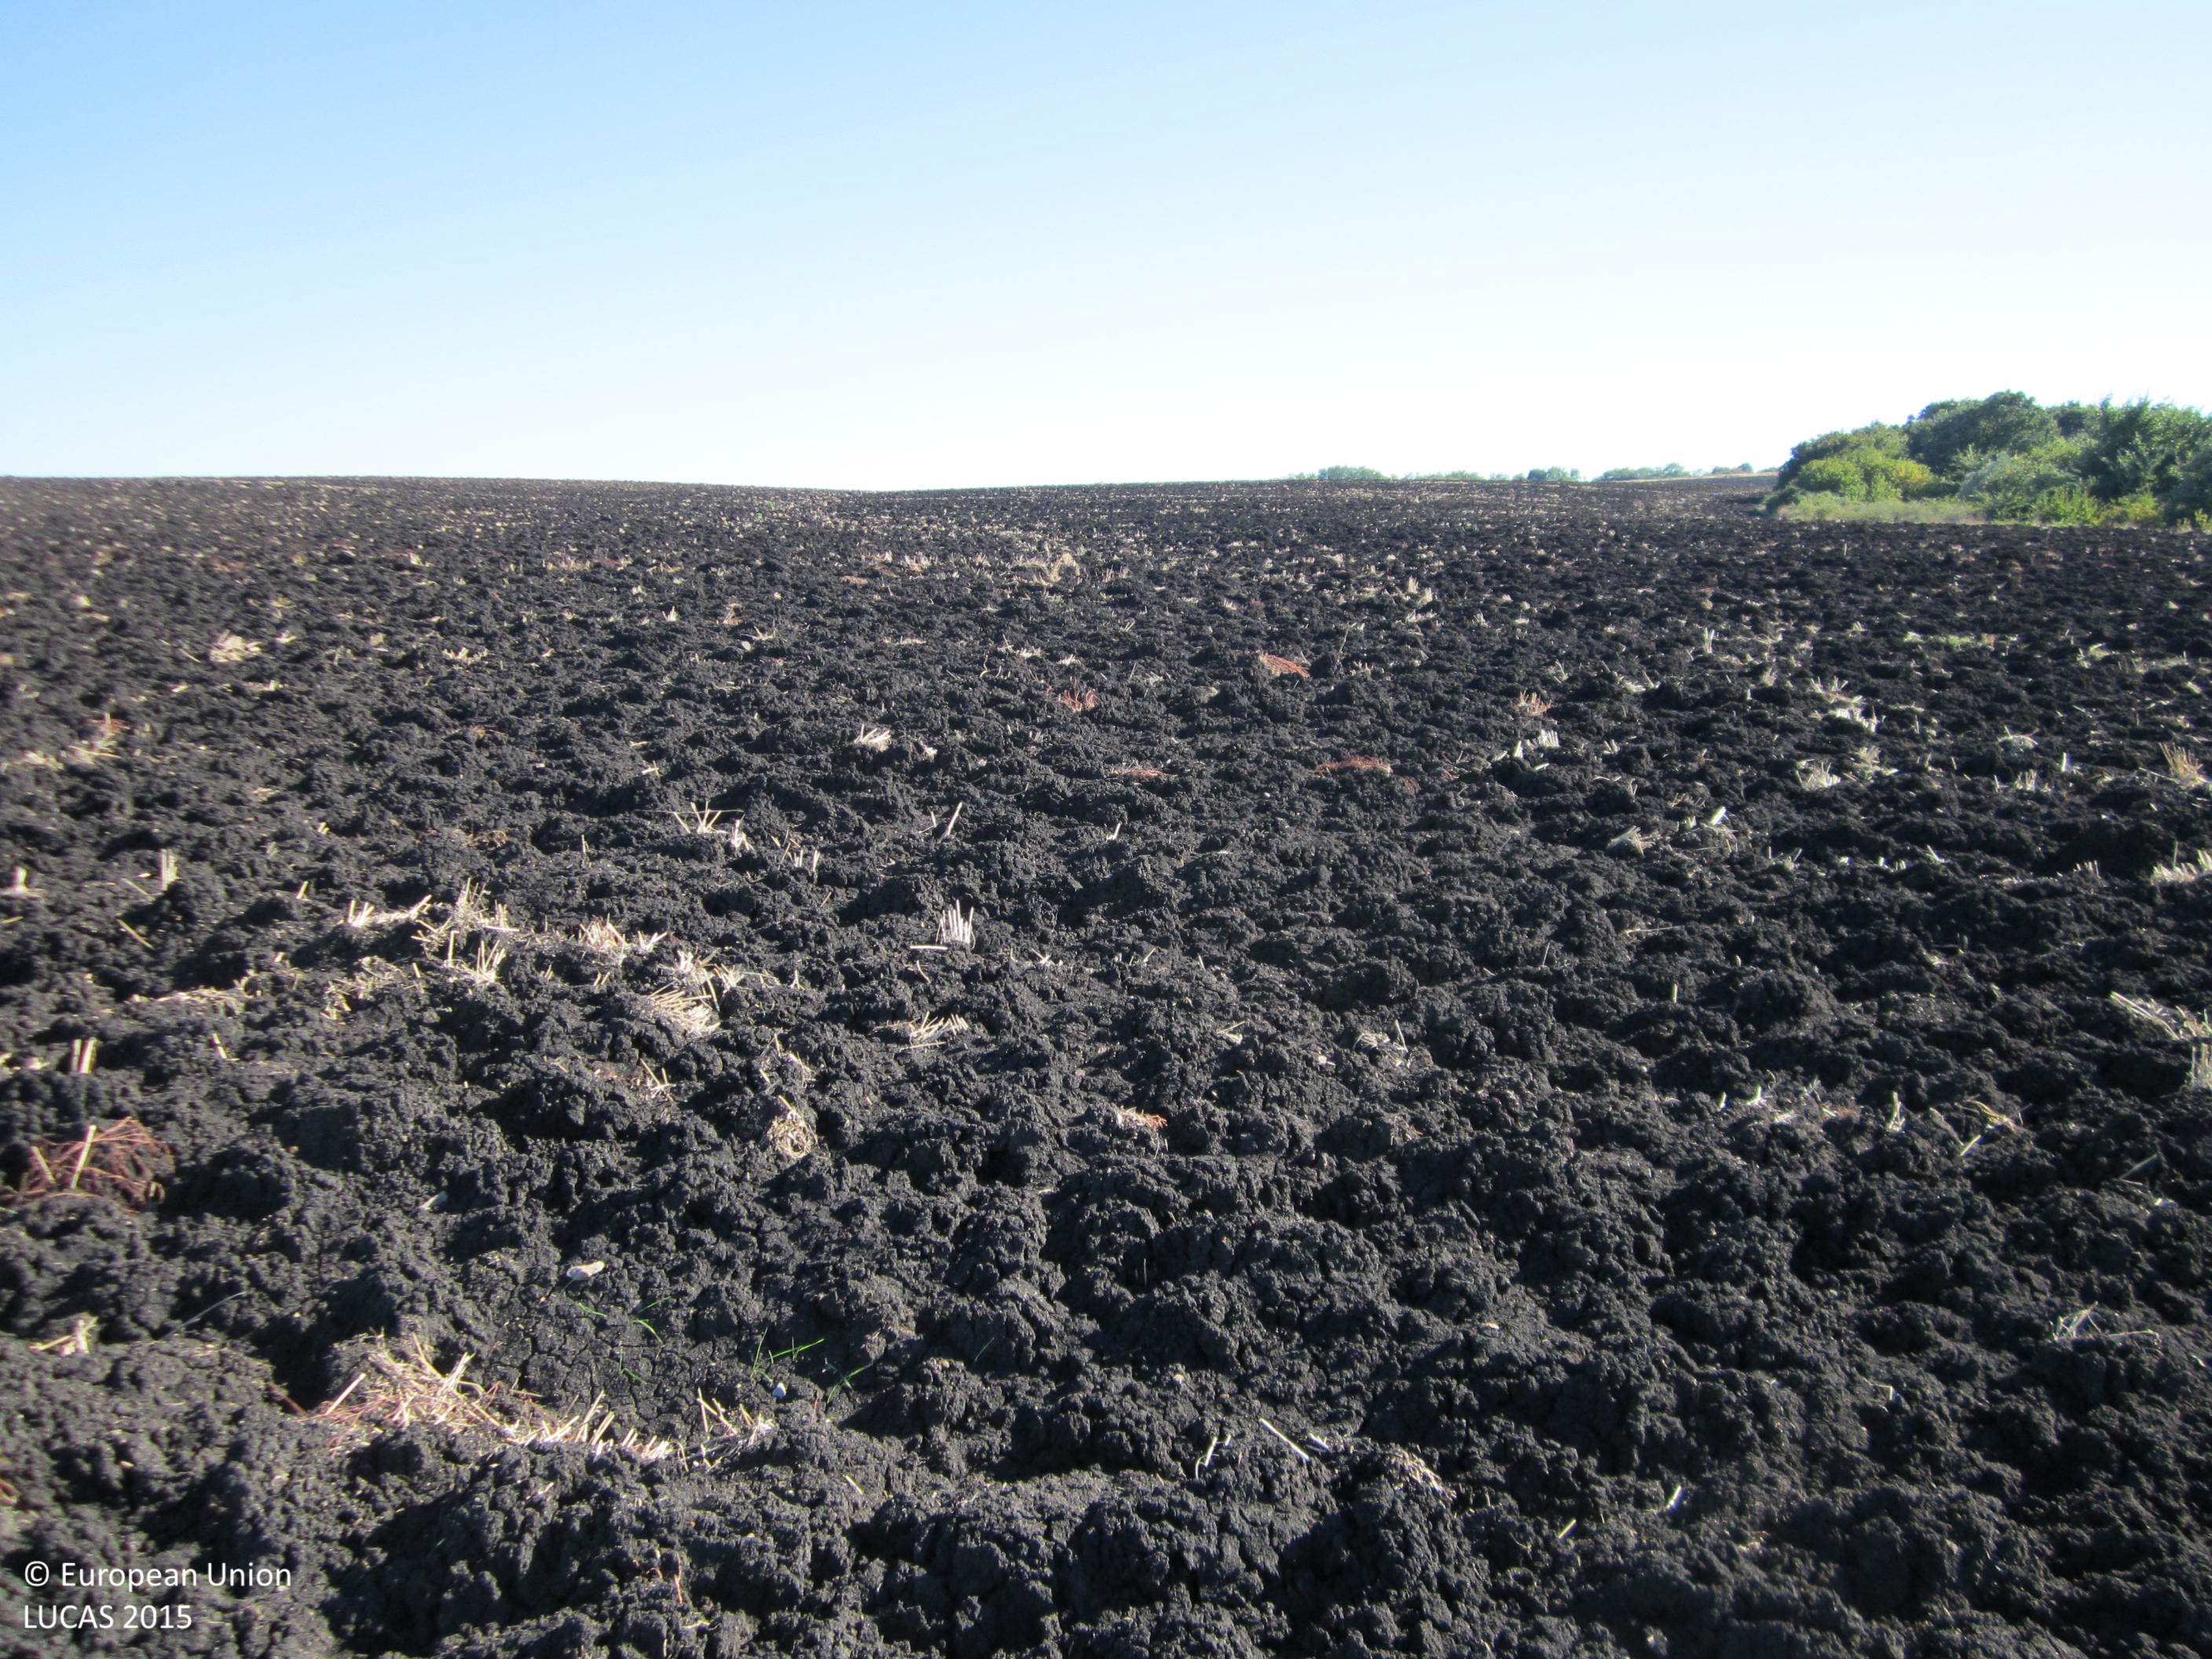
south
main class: Cropland
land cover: Common wheat
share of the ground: < 10 %
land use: Agriculture (excluding fallow land and kitchen gardens)
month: September
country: BG
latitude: 42.4629
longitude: 27.0710
